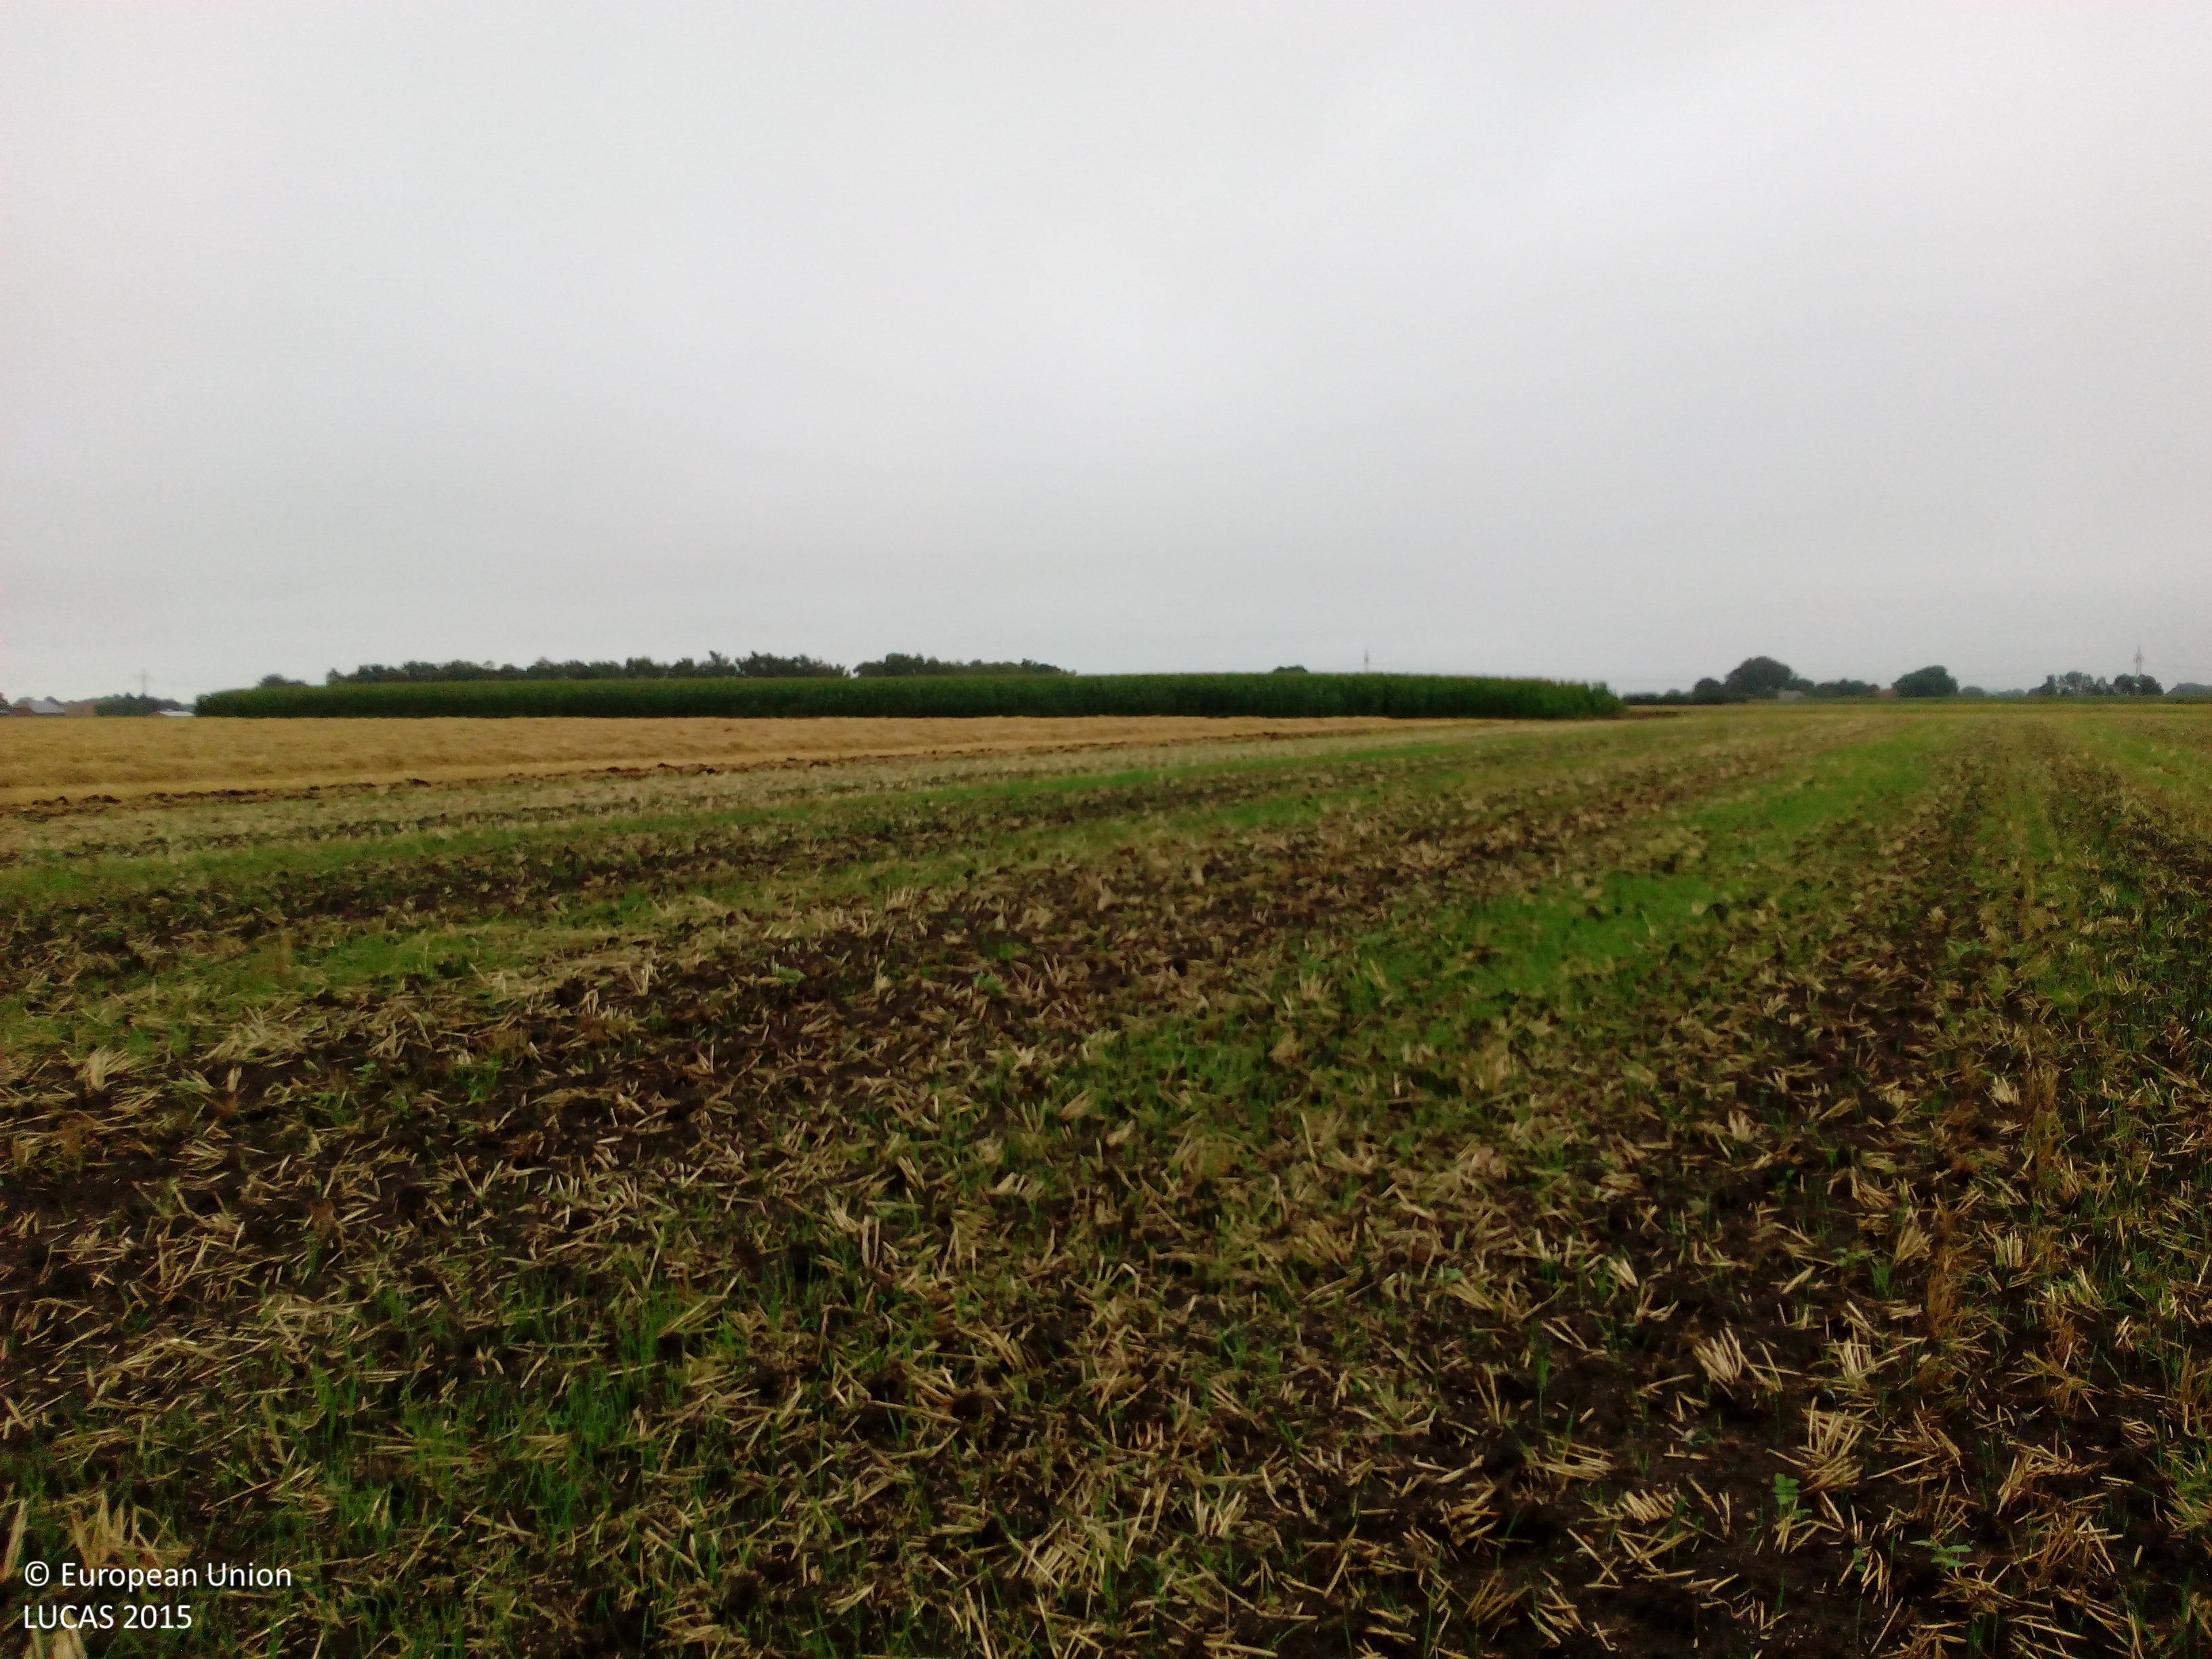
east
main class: Cropland
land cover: Common wheat
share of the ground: 25 - 50 %
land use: Agriculture (excluding fallow land and kitchen gardens)
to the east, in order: Common wheat; Grass margins; Tracks; Grass margins; Common wheat
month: August
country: DE
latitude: 52.8006
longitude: 8.5914
